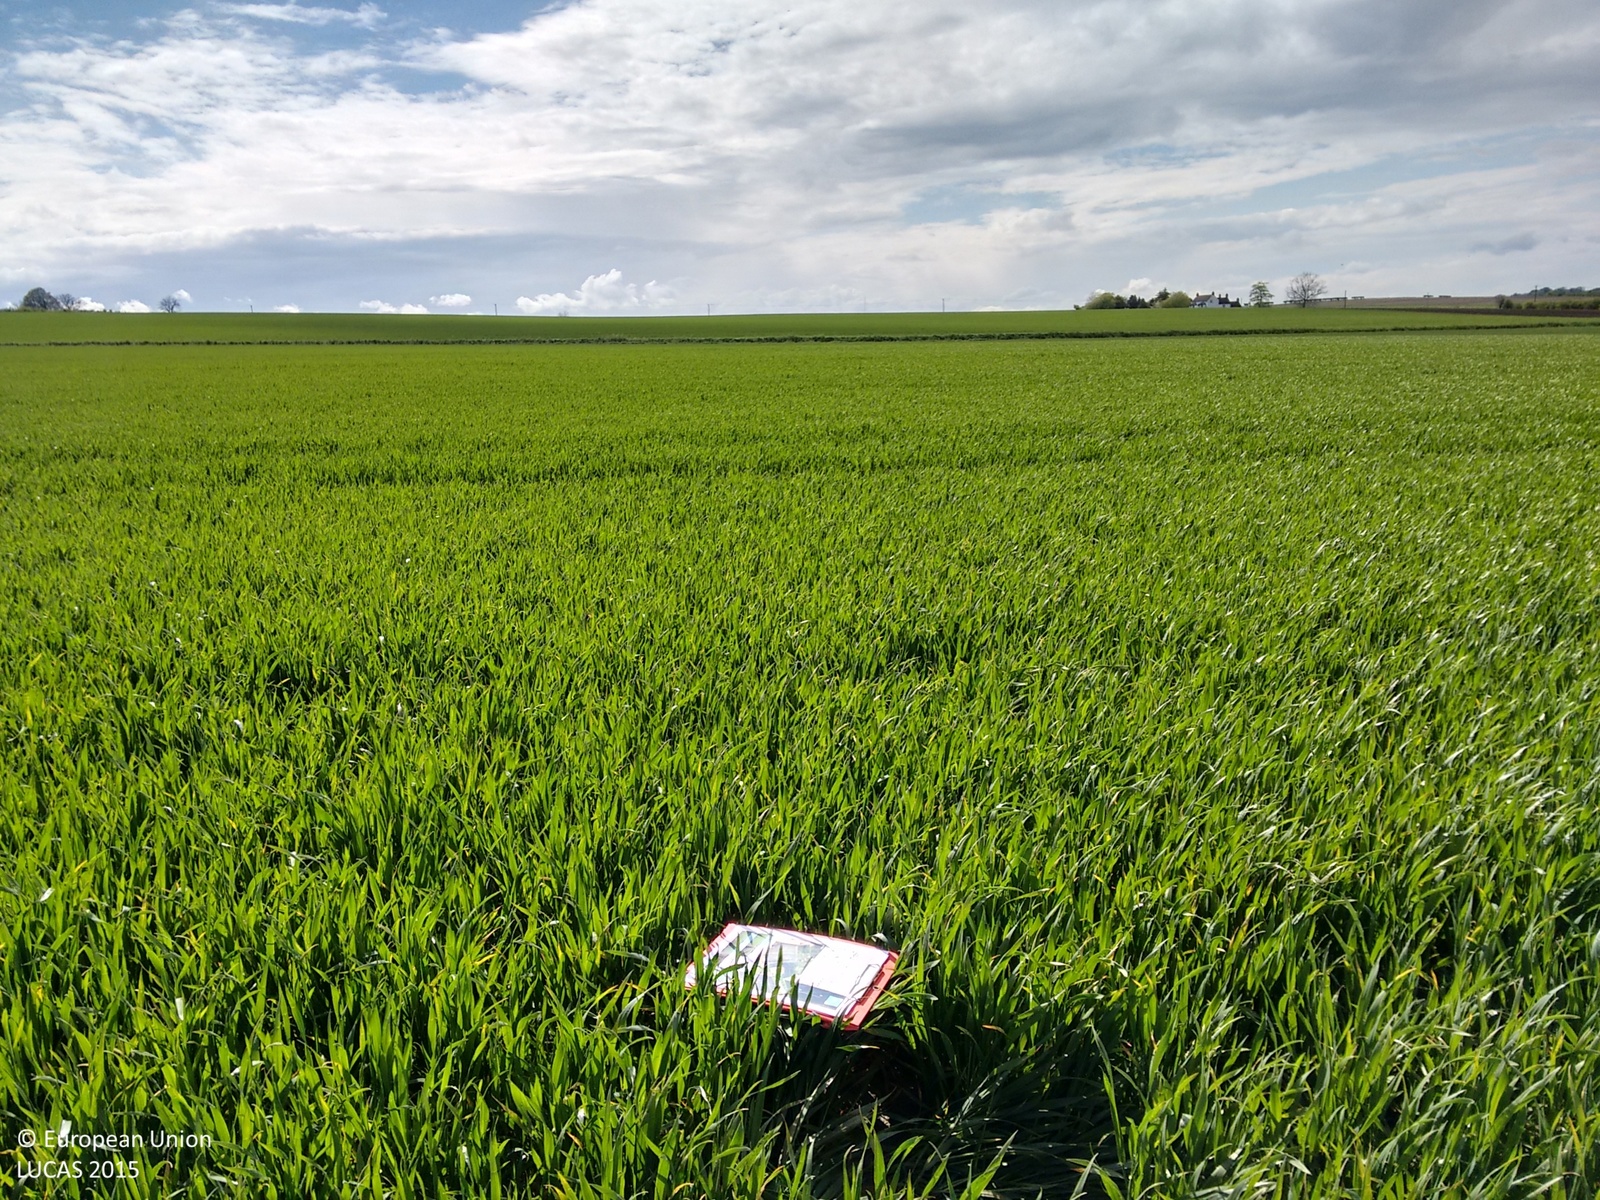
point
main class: Cropland
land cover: Common wheat
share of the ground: > 75 %
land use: Agriculture (excluding fallow land and kitchen gardens)
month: May
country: GB
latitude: 53.3501
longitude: 0.0083
